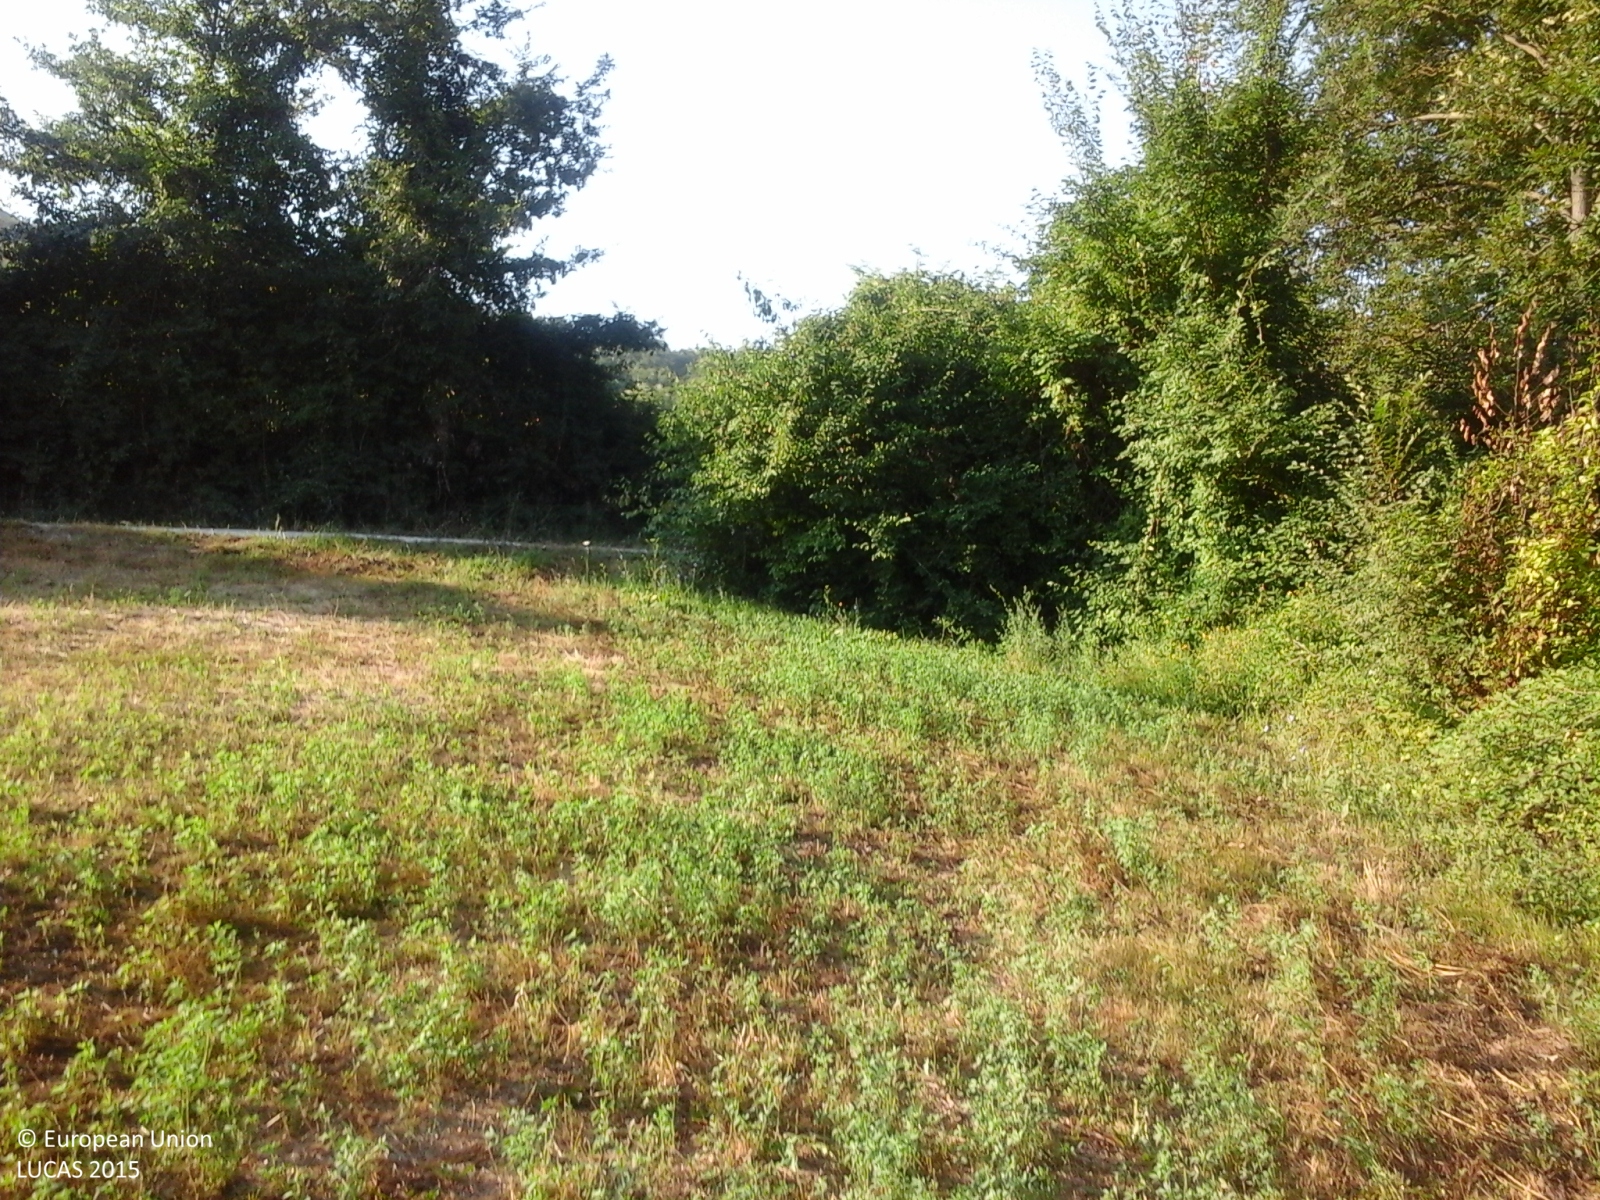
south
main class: Woodland
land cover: Broadleaved woodland
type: thermophilous deciduous forest
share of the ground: > 75 %
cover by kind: broadleaved forest trees 100 %
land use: Semi-natural and natural areas not in use
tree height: > 5 m
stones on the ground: < 10 %
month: August
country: IT
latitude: 43.6007
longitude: 12.4095
